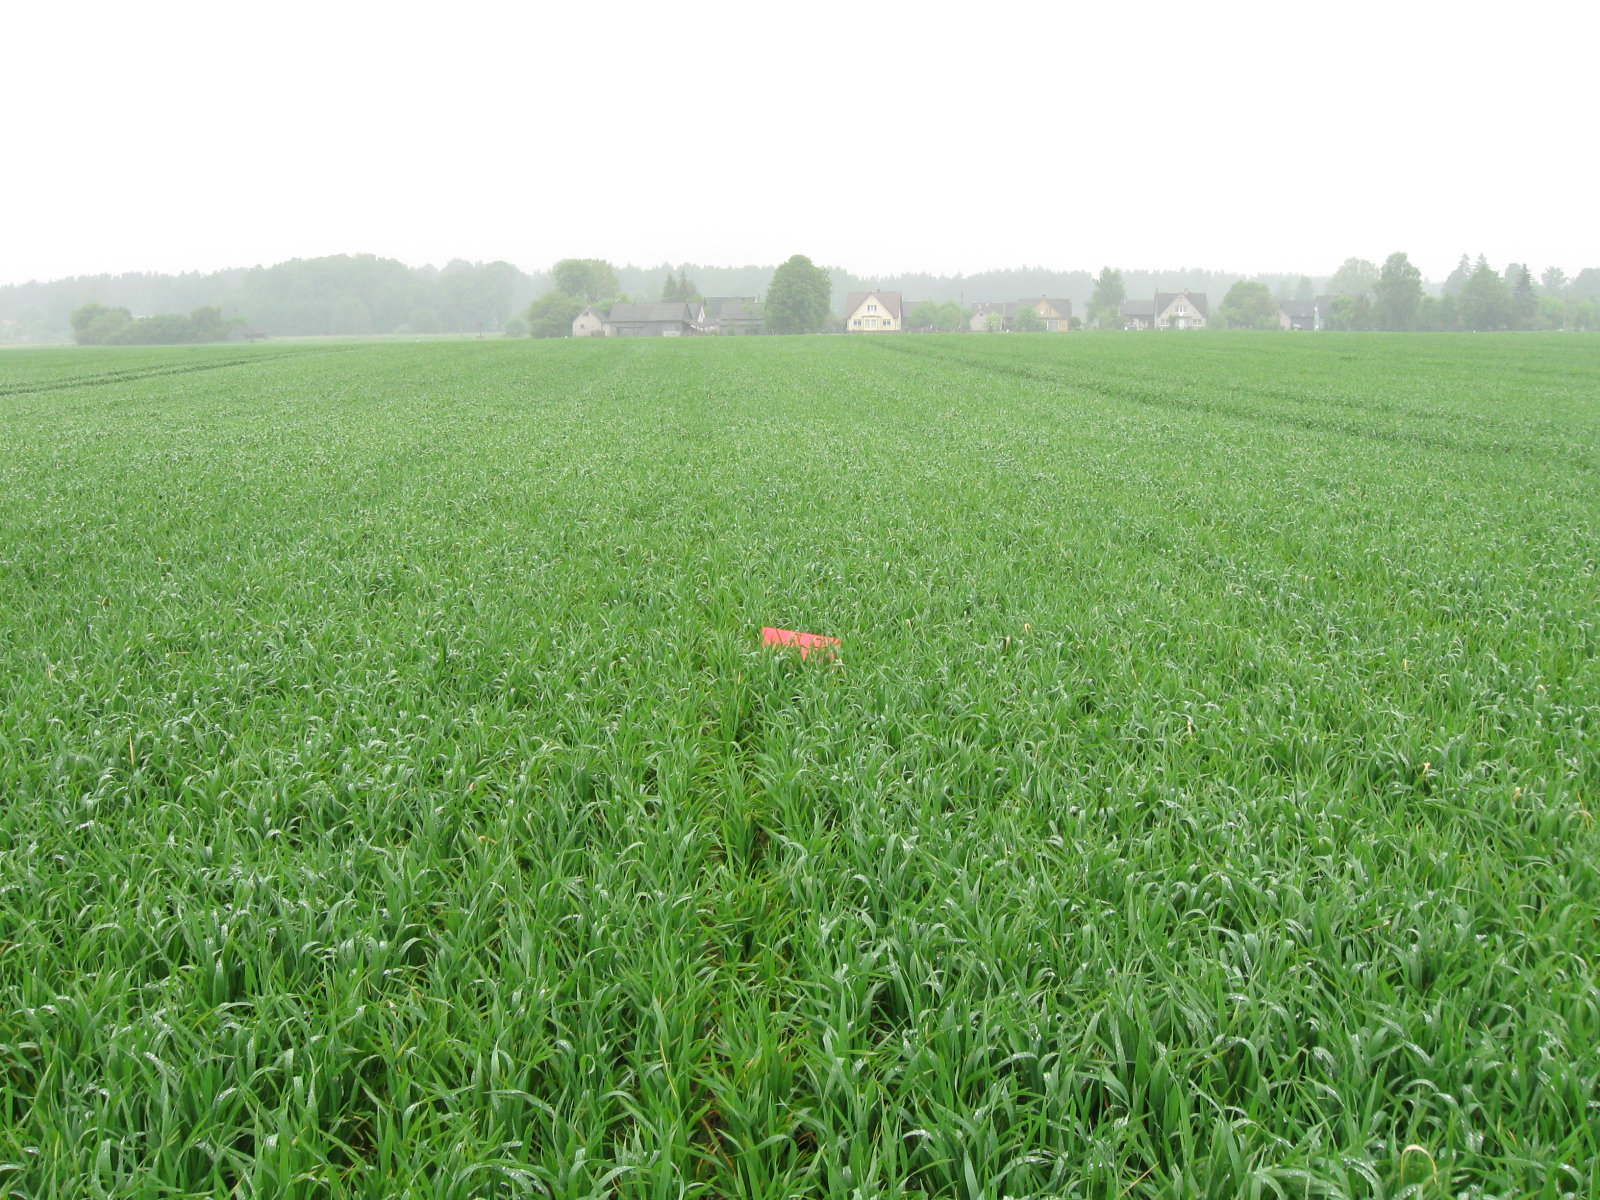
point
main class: Cropland
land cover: Common wheat
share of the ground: > 75 %
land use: Agriculture (excluding fallow land and kitchen gardens)
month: May
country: LT
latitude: 55.0405
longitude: 22.7261
